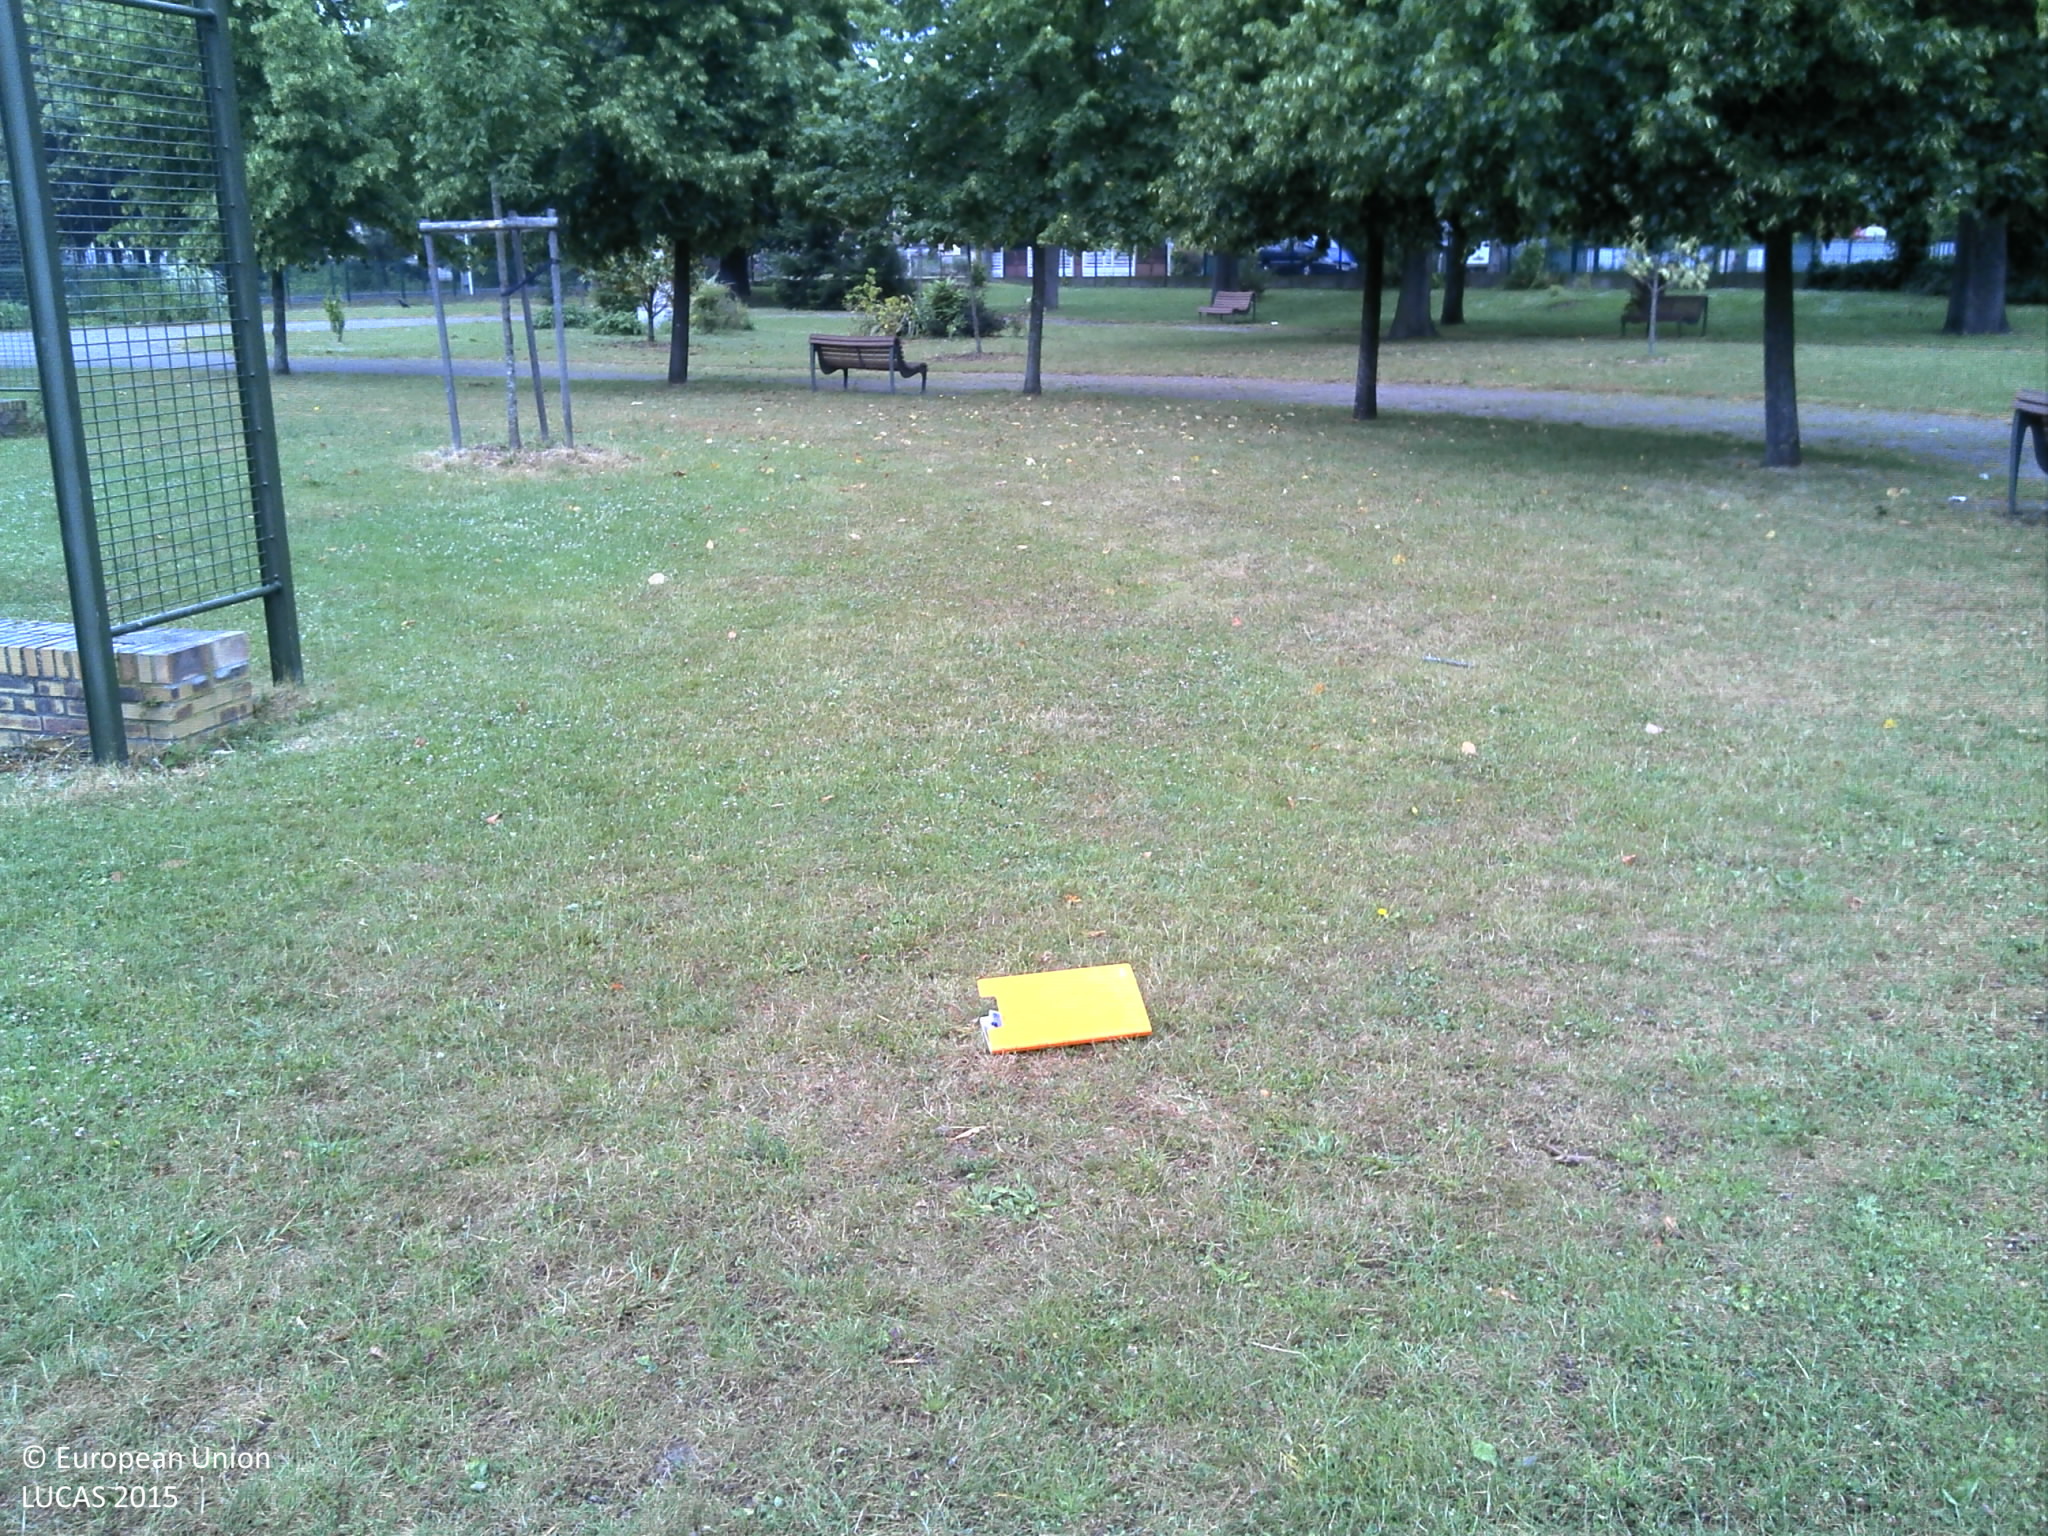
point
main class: Grassland
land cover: Grassland with sparse tree/shrub cover
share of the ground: > 75 %
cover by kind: herbaceous plants 95 %, broadleaved forest trees 5 %
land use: Amenities, museums, leisure
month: June
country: FR
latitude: 49.4141
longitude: 1.0324
